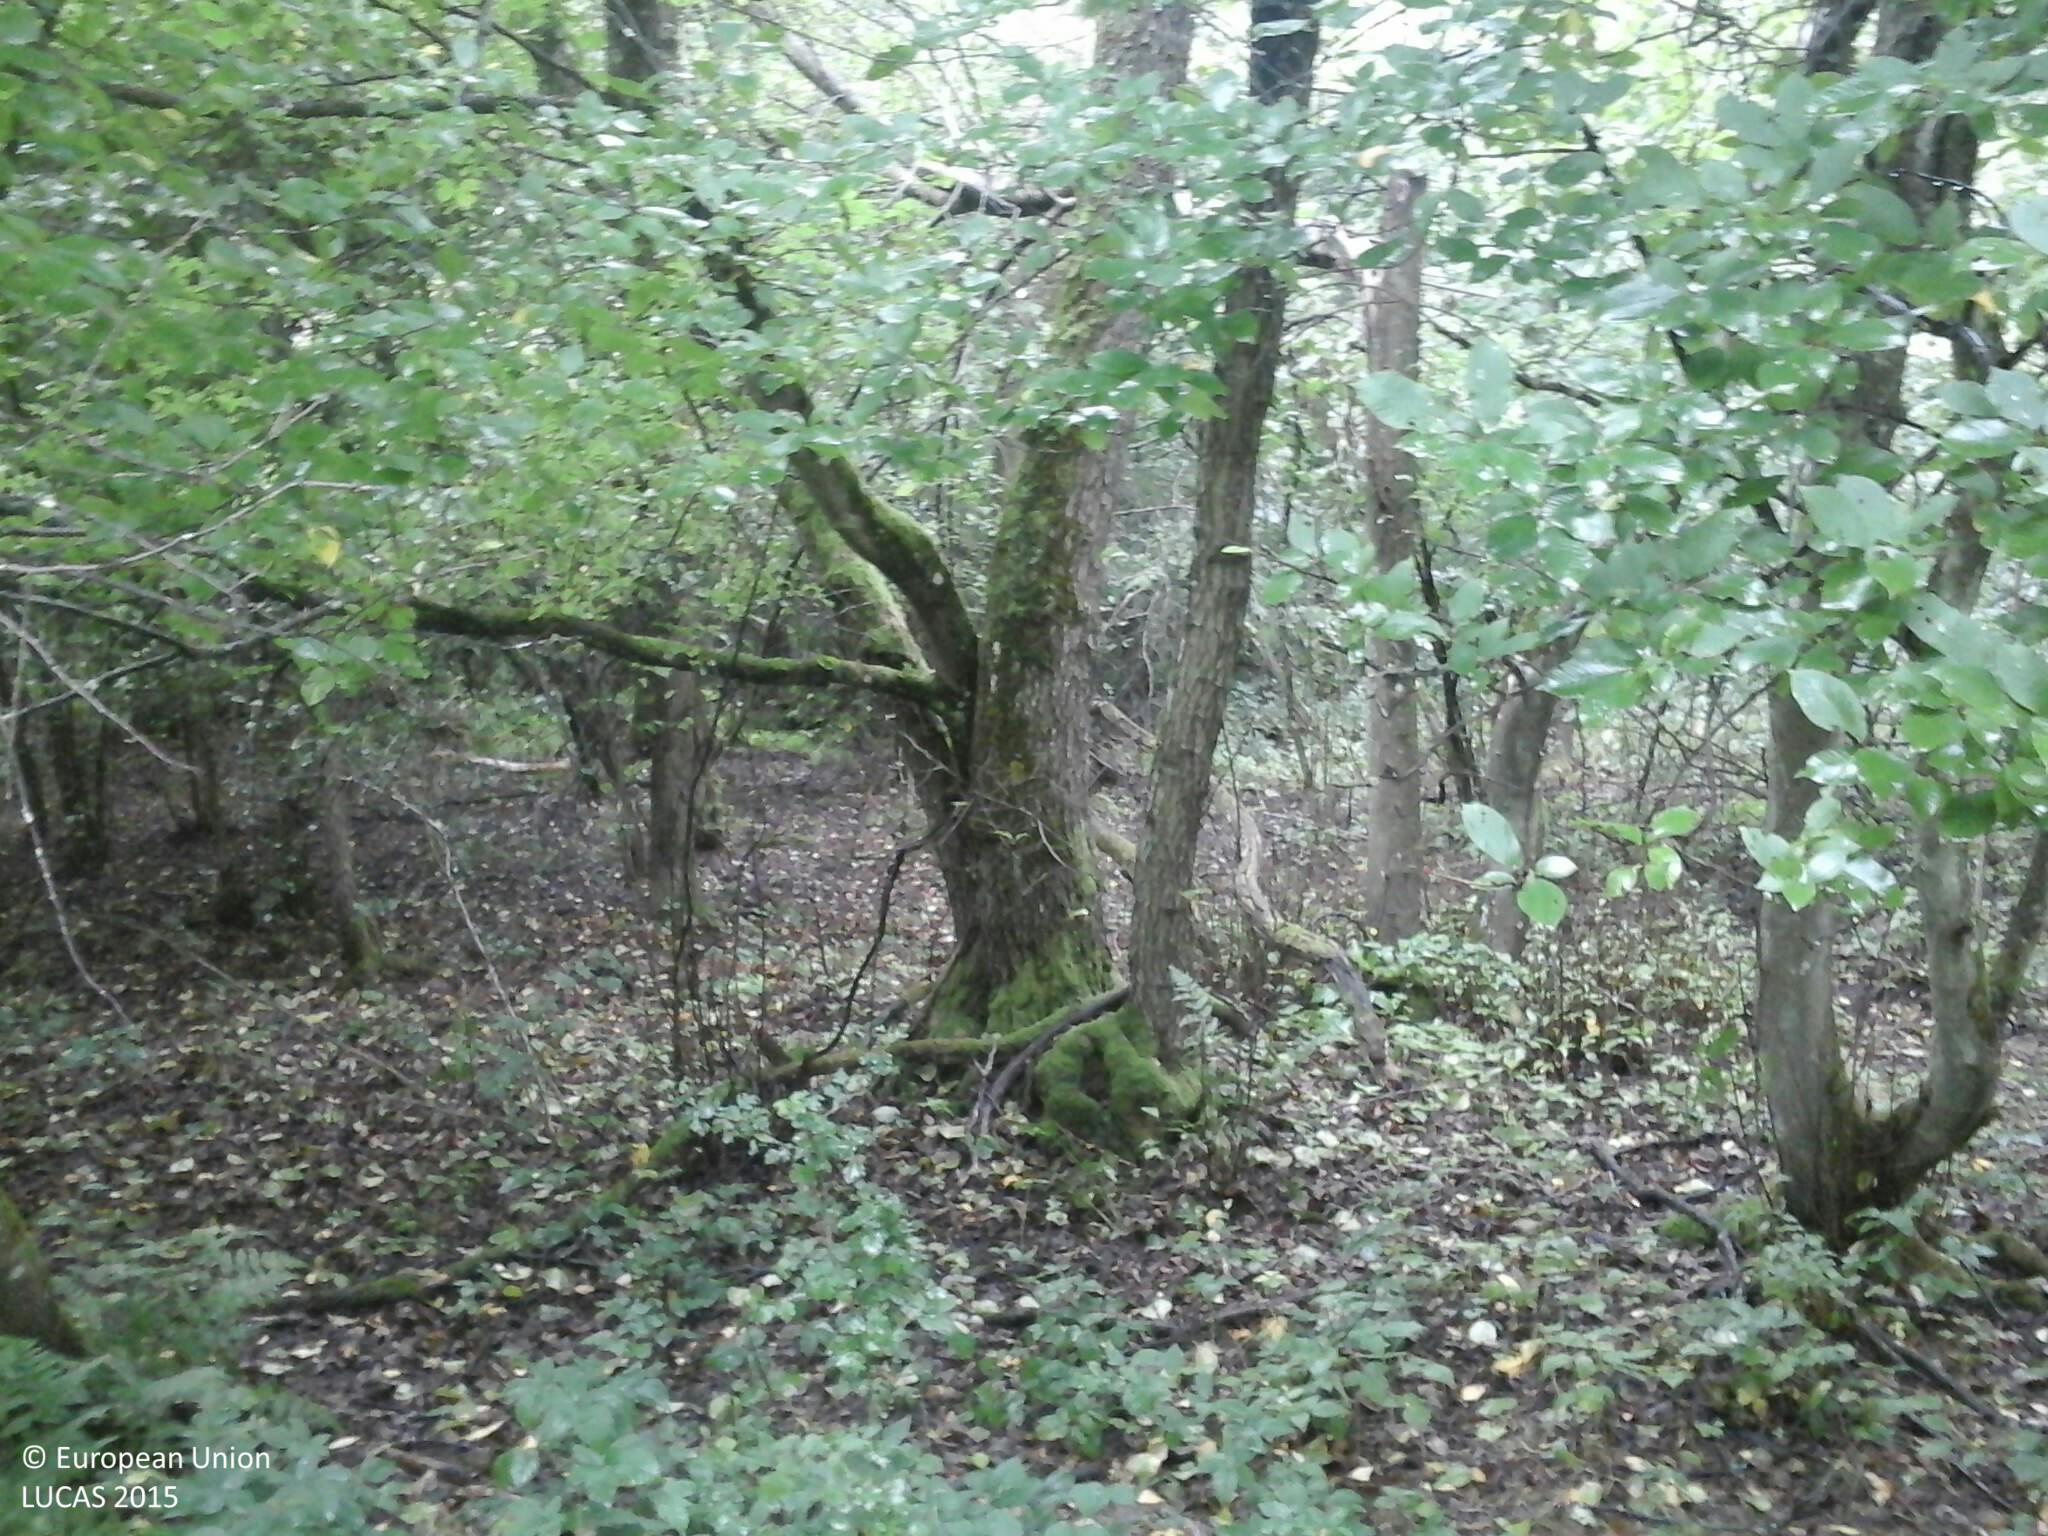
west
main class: Woodland
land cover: Broadleaved woodland
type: mesophytic deciduous forest
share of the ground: > 75 %
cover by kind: broadleaved forest trees 75 %, herbaceous plants 15 %, shrubs 10 %
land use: Forestry
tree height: > 5 m
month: July
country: HU
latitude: 46.9121
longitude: 16.5015
